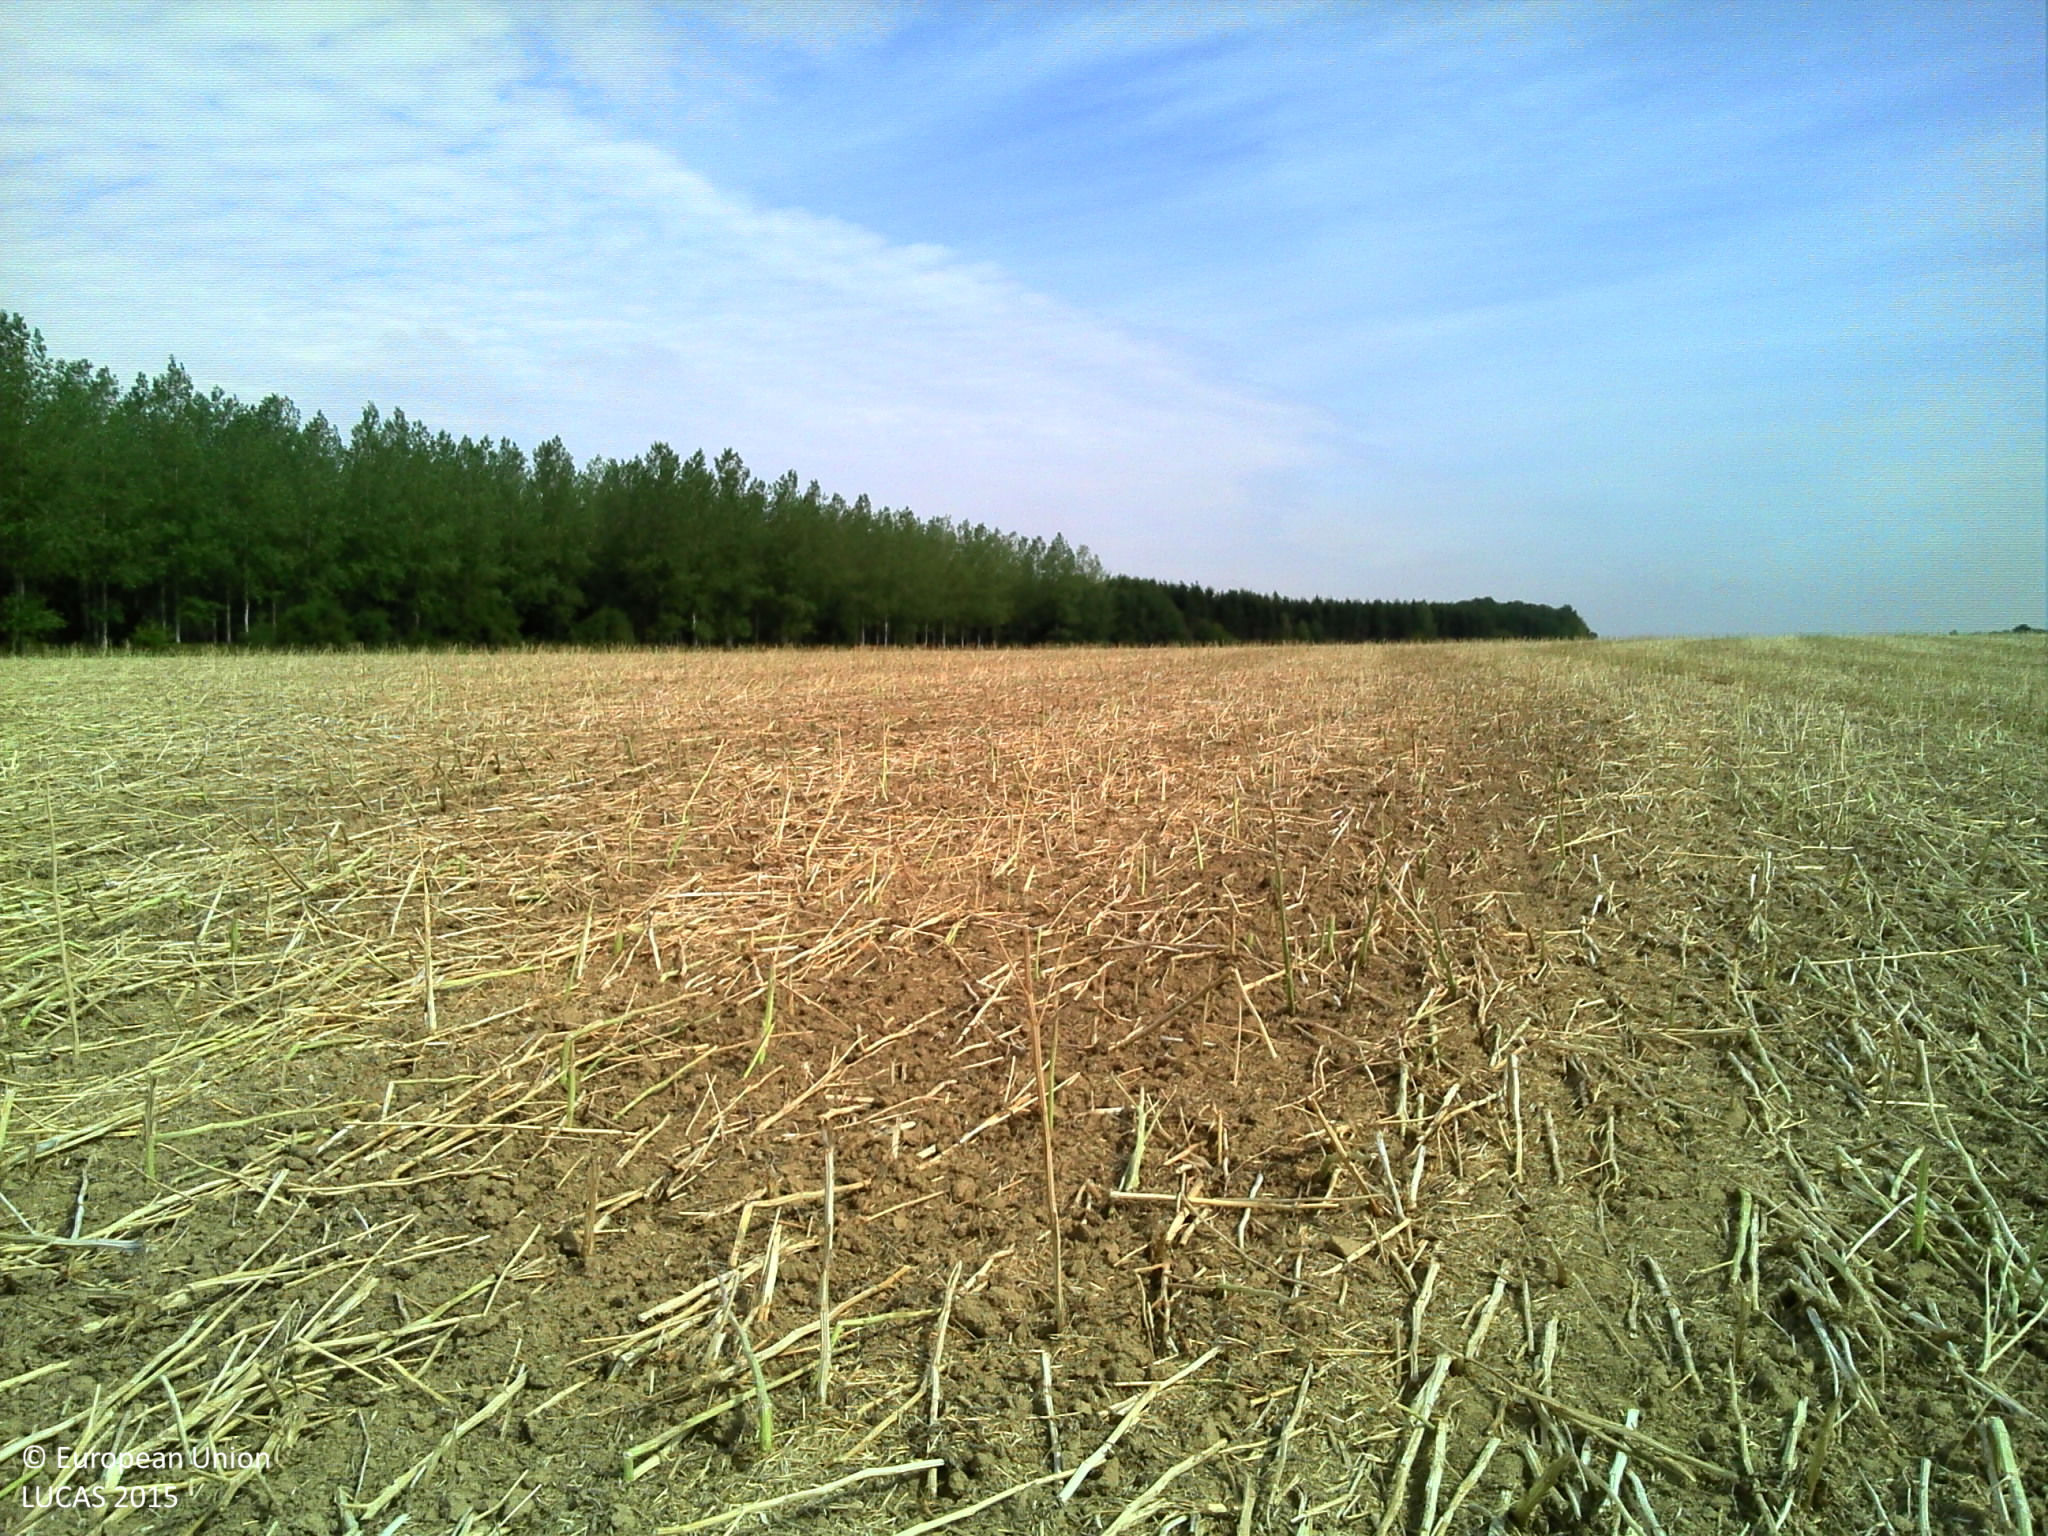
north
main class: Cropland
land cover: Rape and turnip rape
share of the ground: > 75 %
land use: Agriculture (excluding fallow land and kitchen gardens)
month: August
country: FR
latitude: 49.0531
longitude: 3.6859
